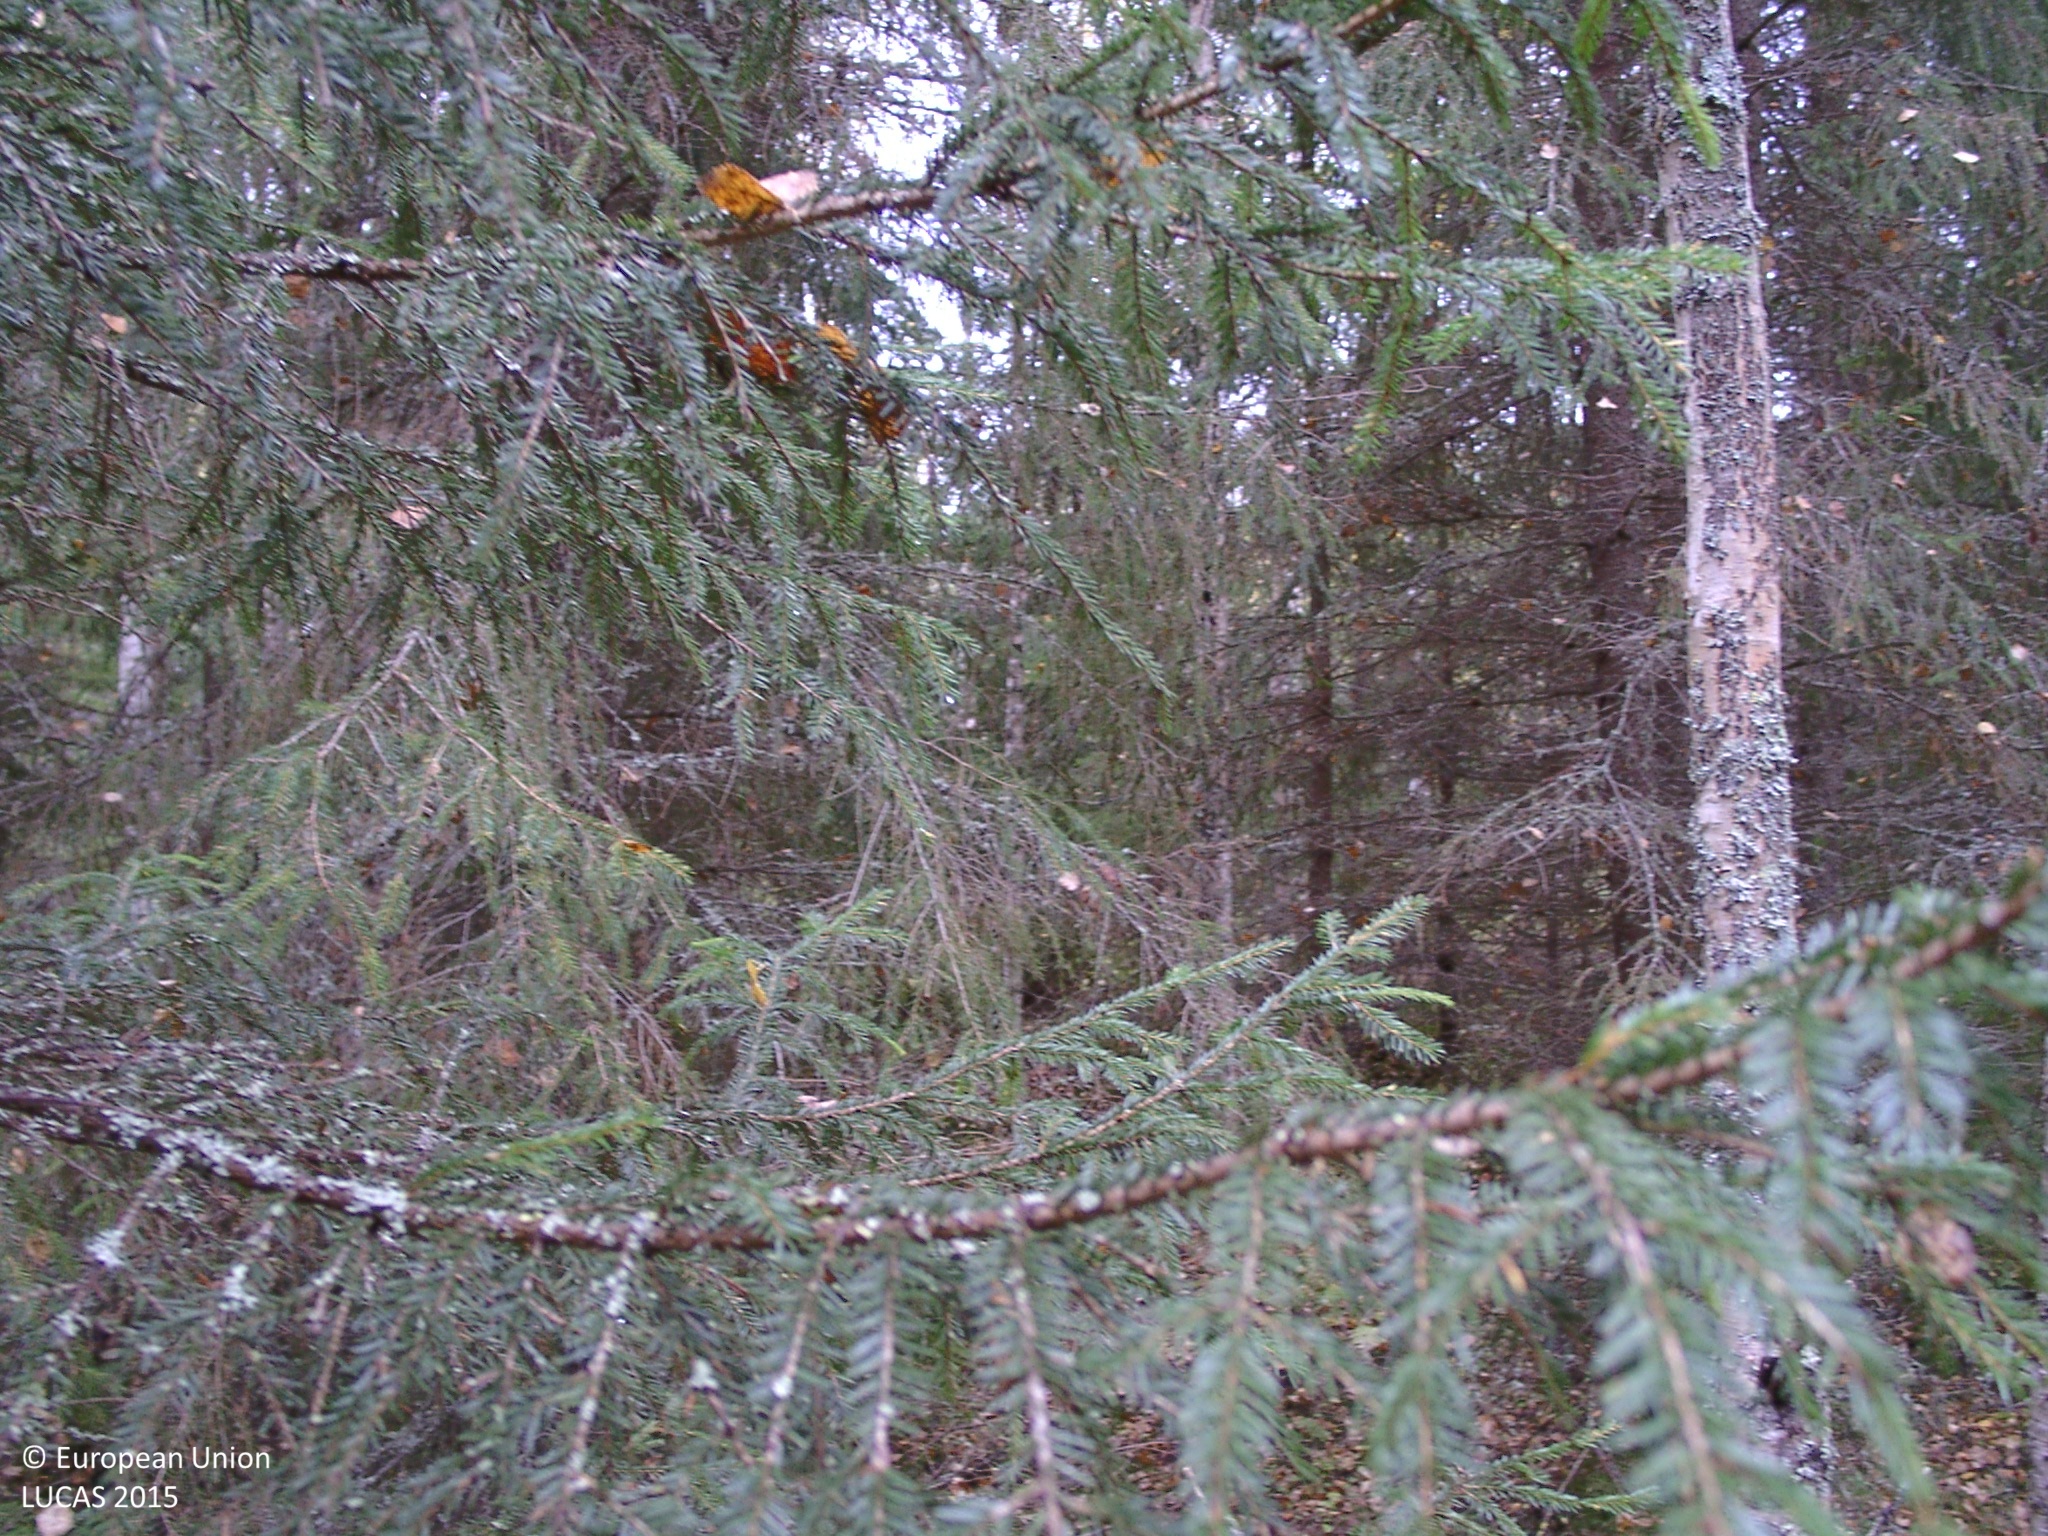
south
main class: Woodland
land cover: Other mixed woodland
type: boreal forest
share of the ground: 50 - 75 %
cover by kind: coniferous forest trees 45 %, broadleaved forest trees 25 %, shrubs 10 %, herbaceous plants 10 %, lichens and mosses 10 %
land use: Forestry
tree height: > 5 m
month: September
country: FI
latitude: 62.6831
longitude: 25.7217
